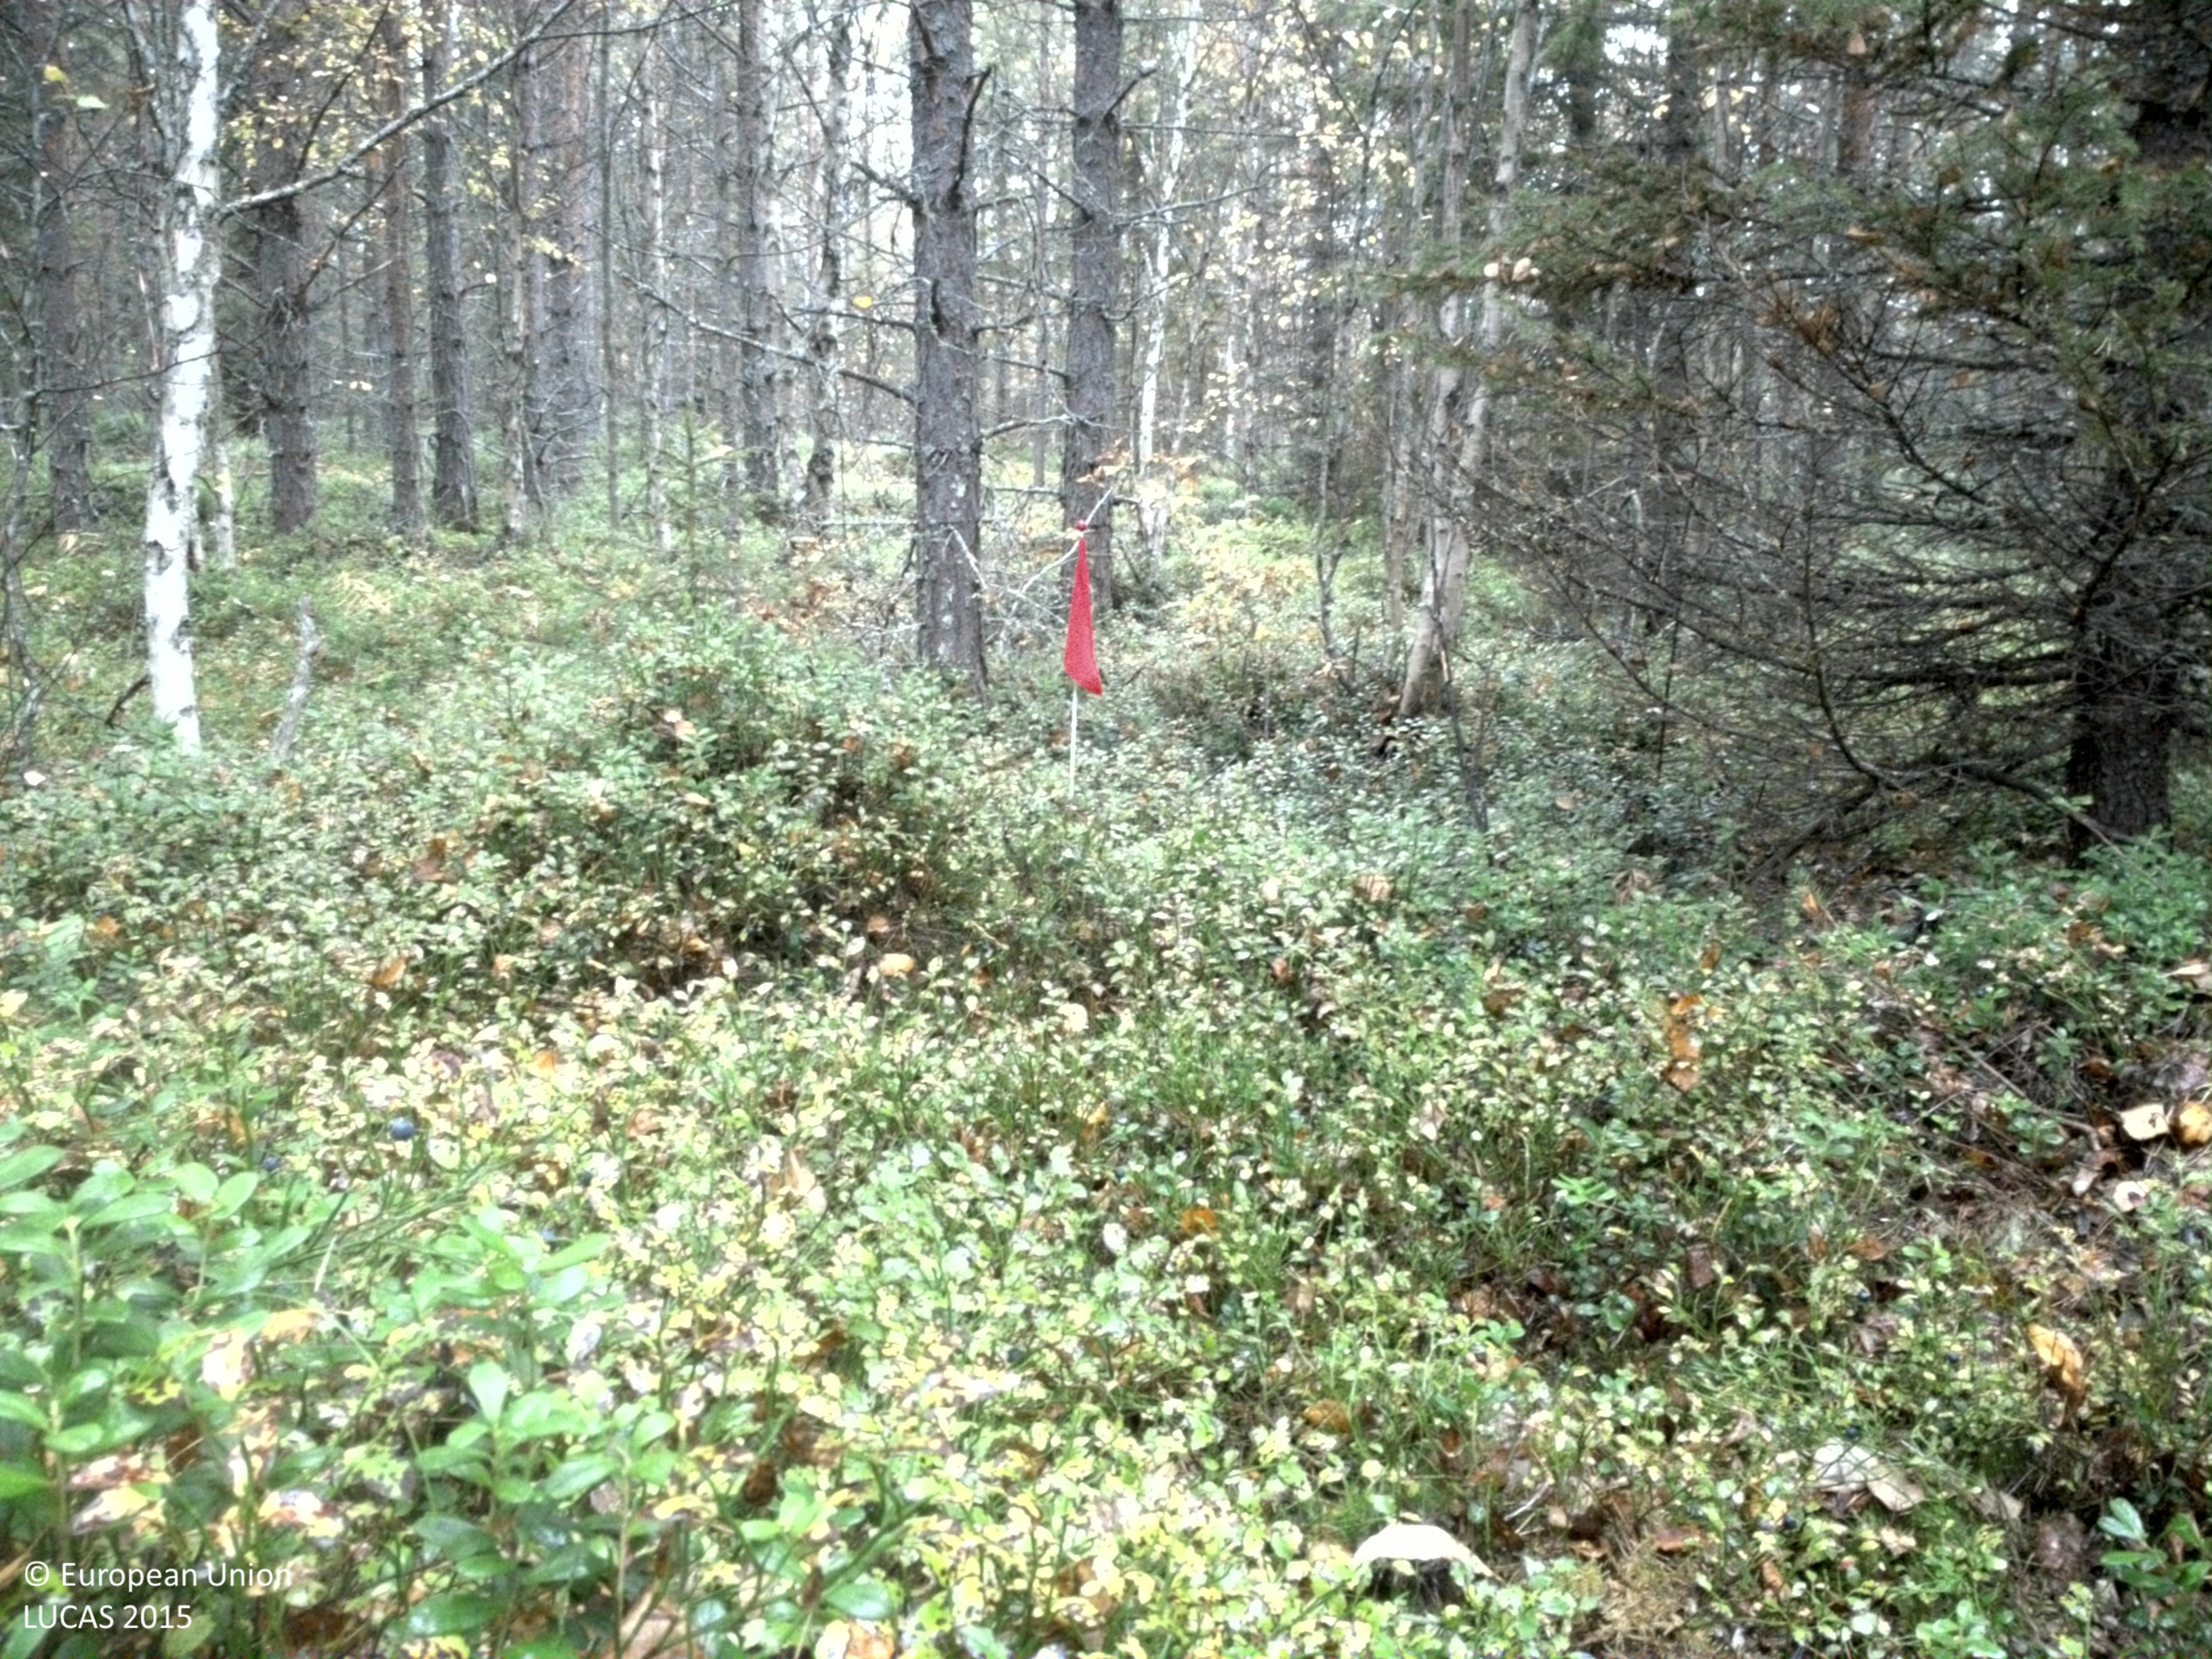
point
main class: Woodland
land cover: Pine dominated coniferous woodland
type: boreal forest
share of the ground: 25 - 50 %
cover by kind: shrubs 50 %, coniferous forest trees 35 %, broadleaved forest trees 10 %, lichens and mosses 5 %
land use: Forestry
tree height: > 5 m
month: September
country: SE
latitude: 65.7990
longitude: 22.1539
